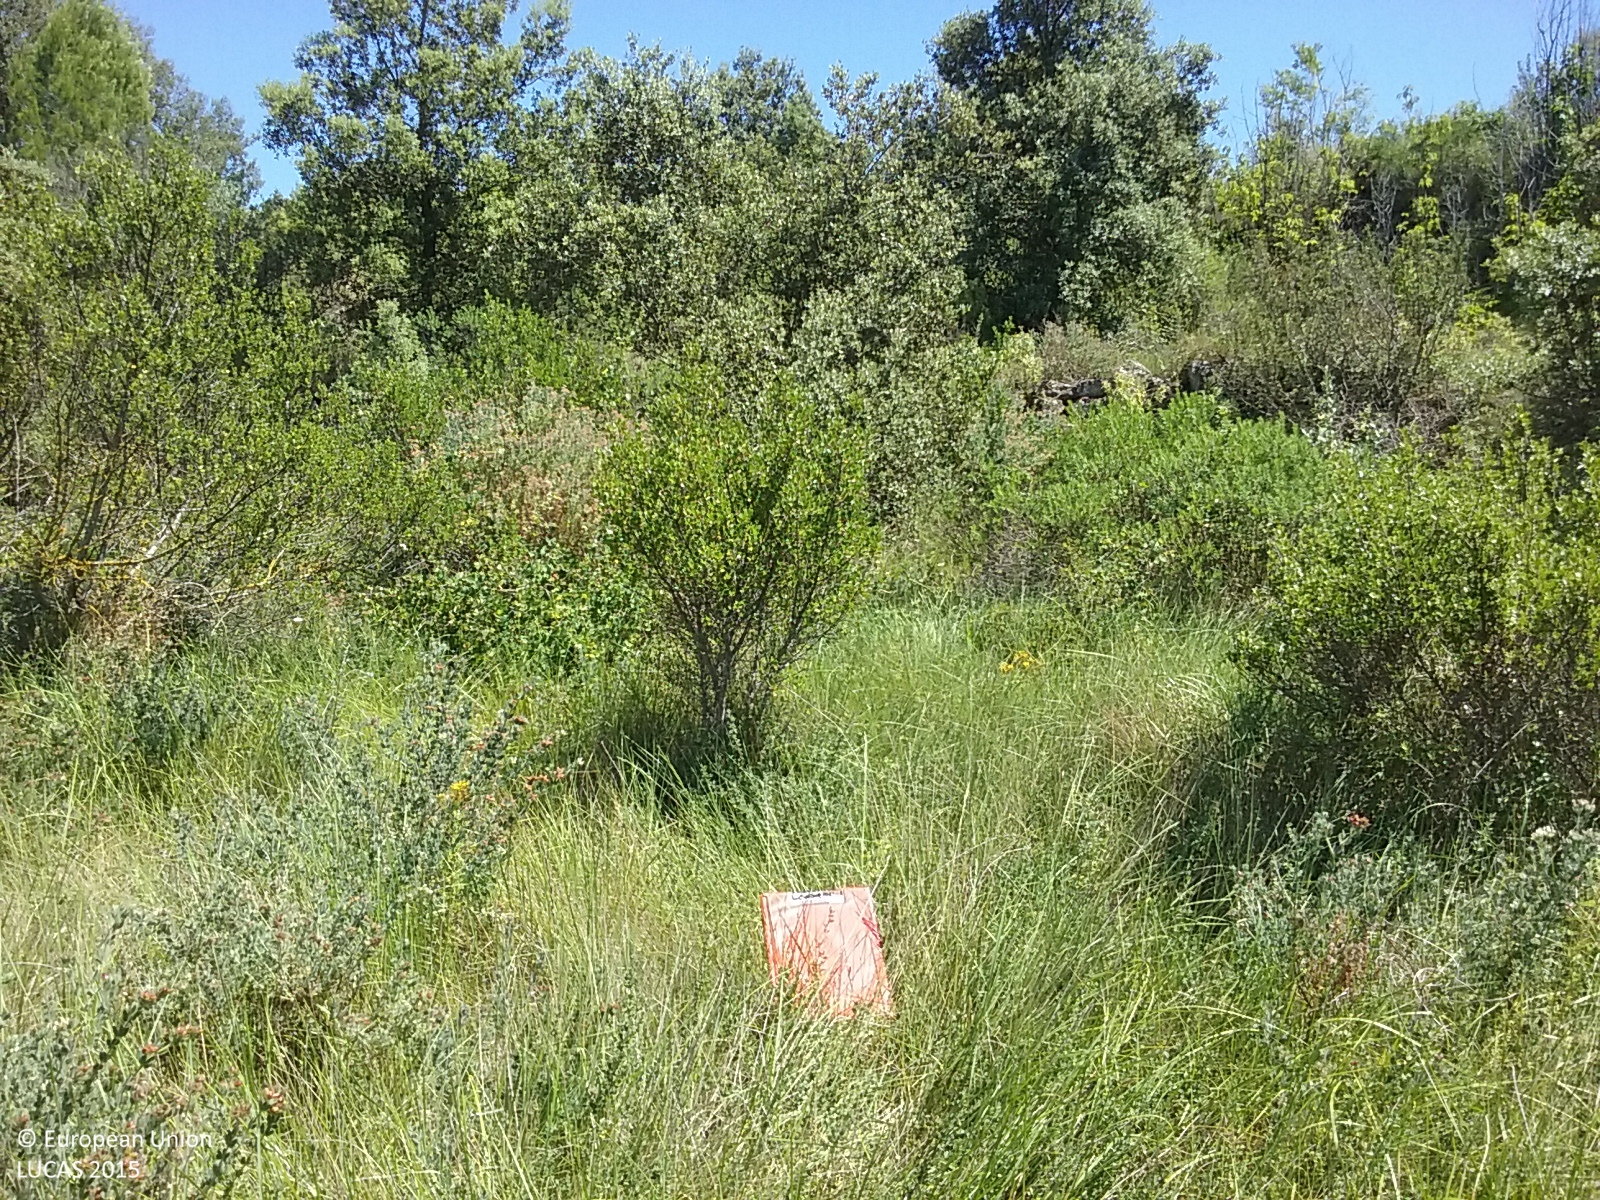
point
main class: Shrubland
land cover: Shrubland with sparse tree cover
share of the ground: 50 - 75 %
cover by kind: herbaceous plants 65 %, shrubs 30 %, broadleaved forest trees 5 %
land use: Semi-natural and natural areas not in use
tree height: < 5 m
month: June
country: ES
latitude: 41.0459
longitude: 0.3428
